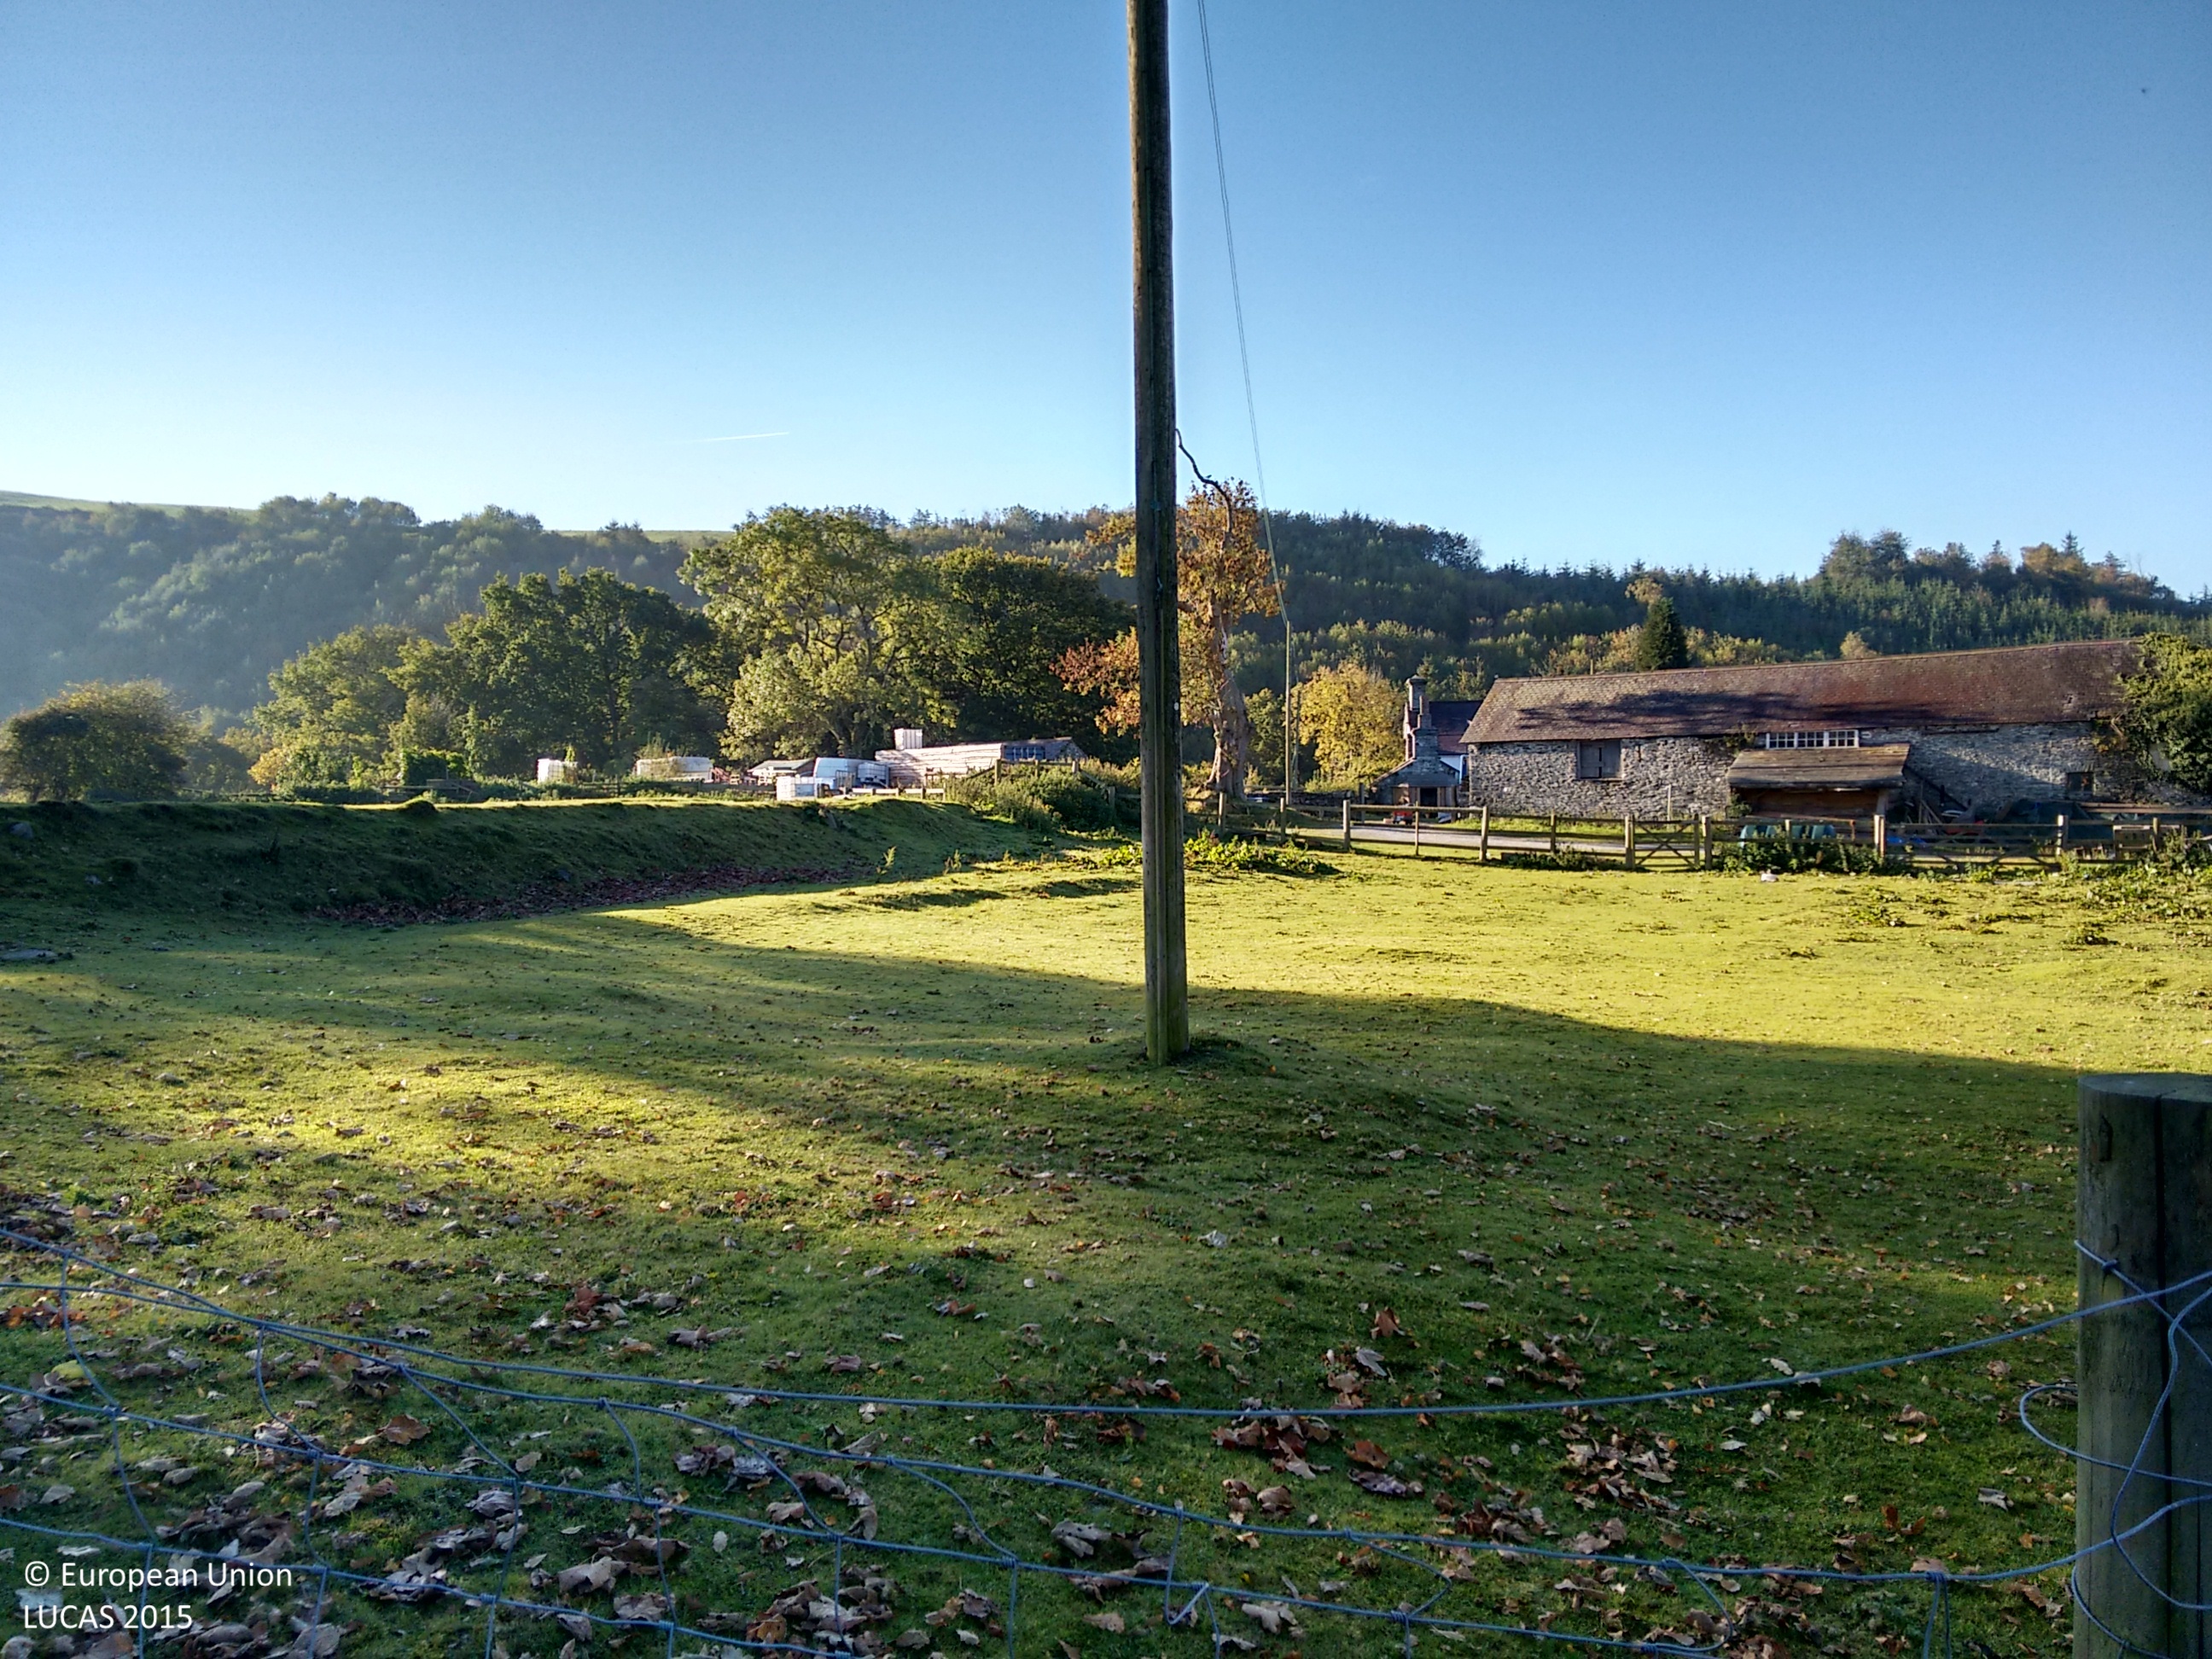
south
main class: Grassland
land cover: Grassland without tree/shrub cover
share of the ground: > 75 %
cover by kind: herbaceous plants 100 %
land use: Agriculture (excluding fallow land and kitchen gardens)
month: October
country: GB
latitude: 52.3531
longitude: -3.9382
